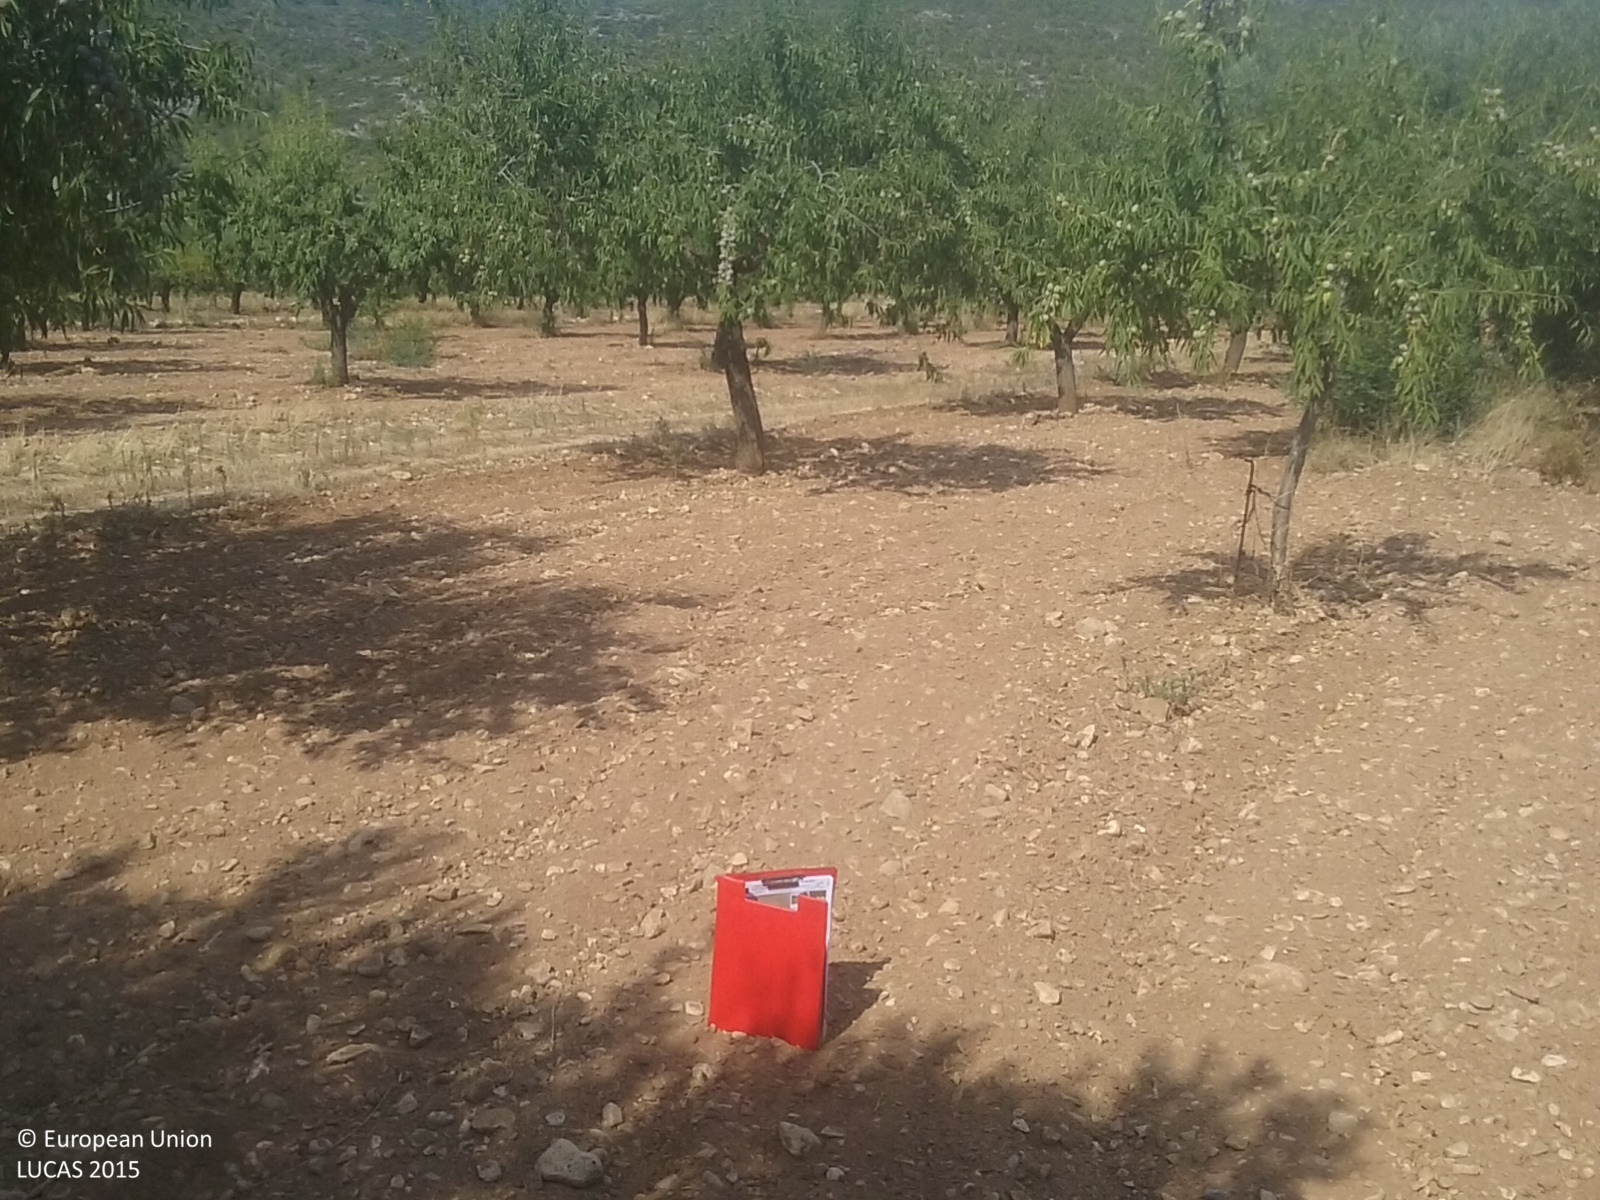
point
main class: Cropland
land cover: Nuts trees
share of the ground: 50 - 75 %
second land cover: Other bare soil
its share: > 75 %
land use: Agriculture (excluding fallow land and kitchen gardens)
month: July
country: ES
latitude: 40.2212
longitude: -0.0743
